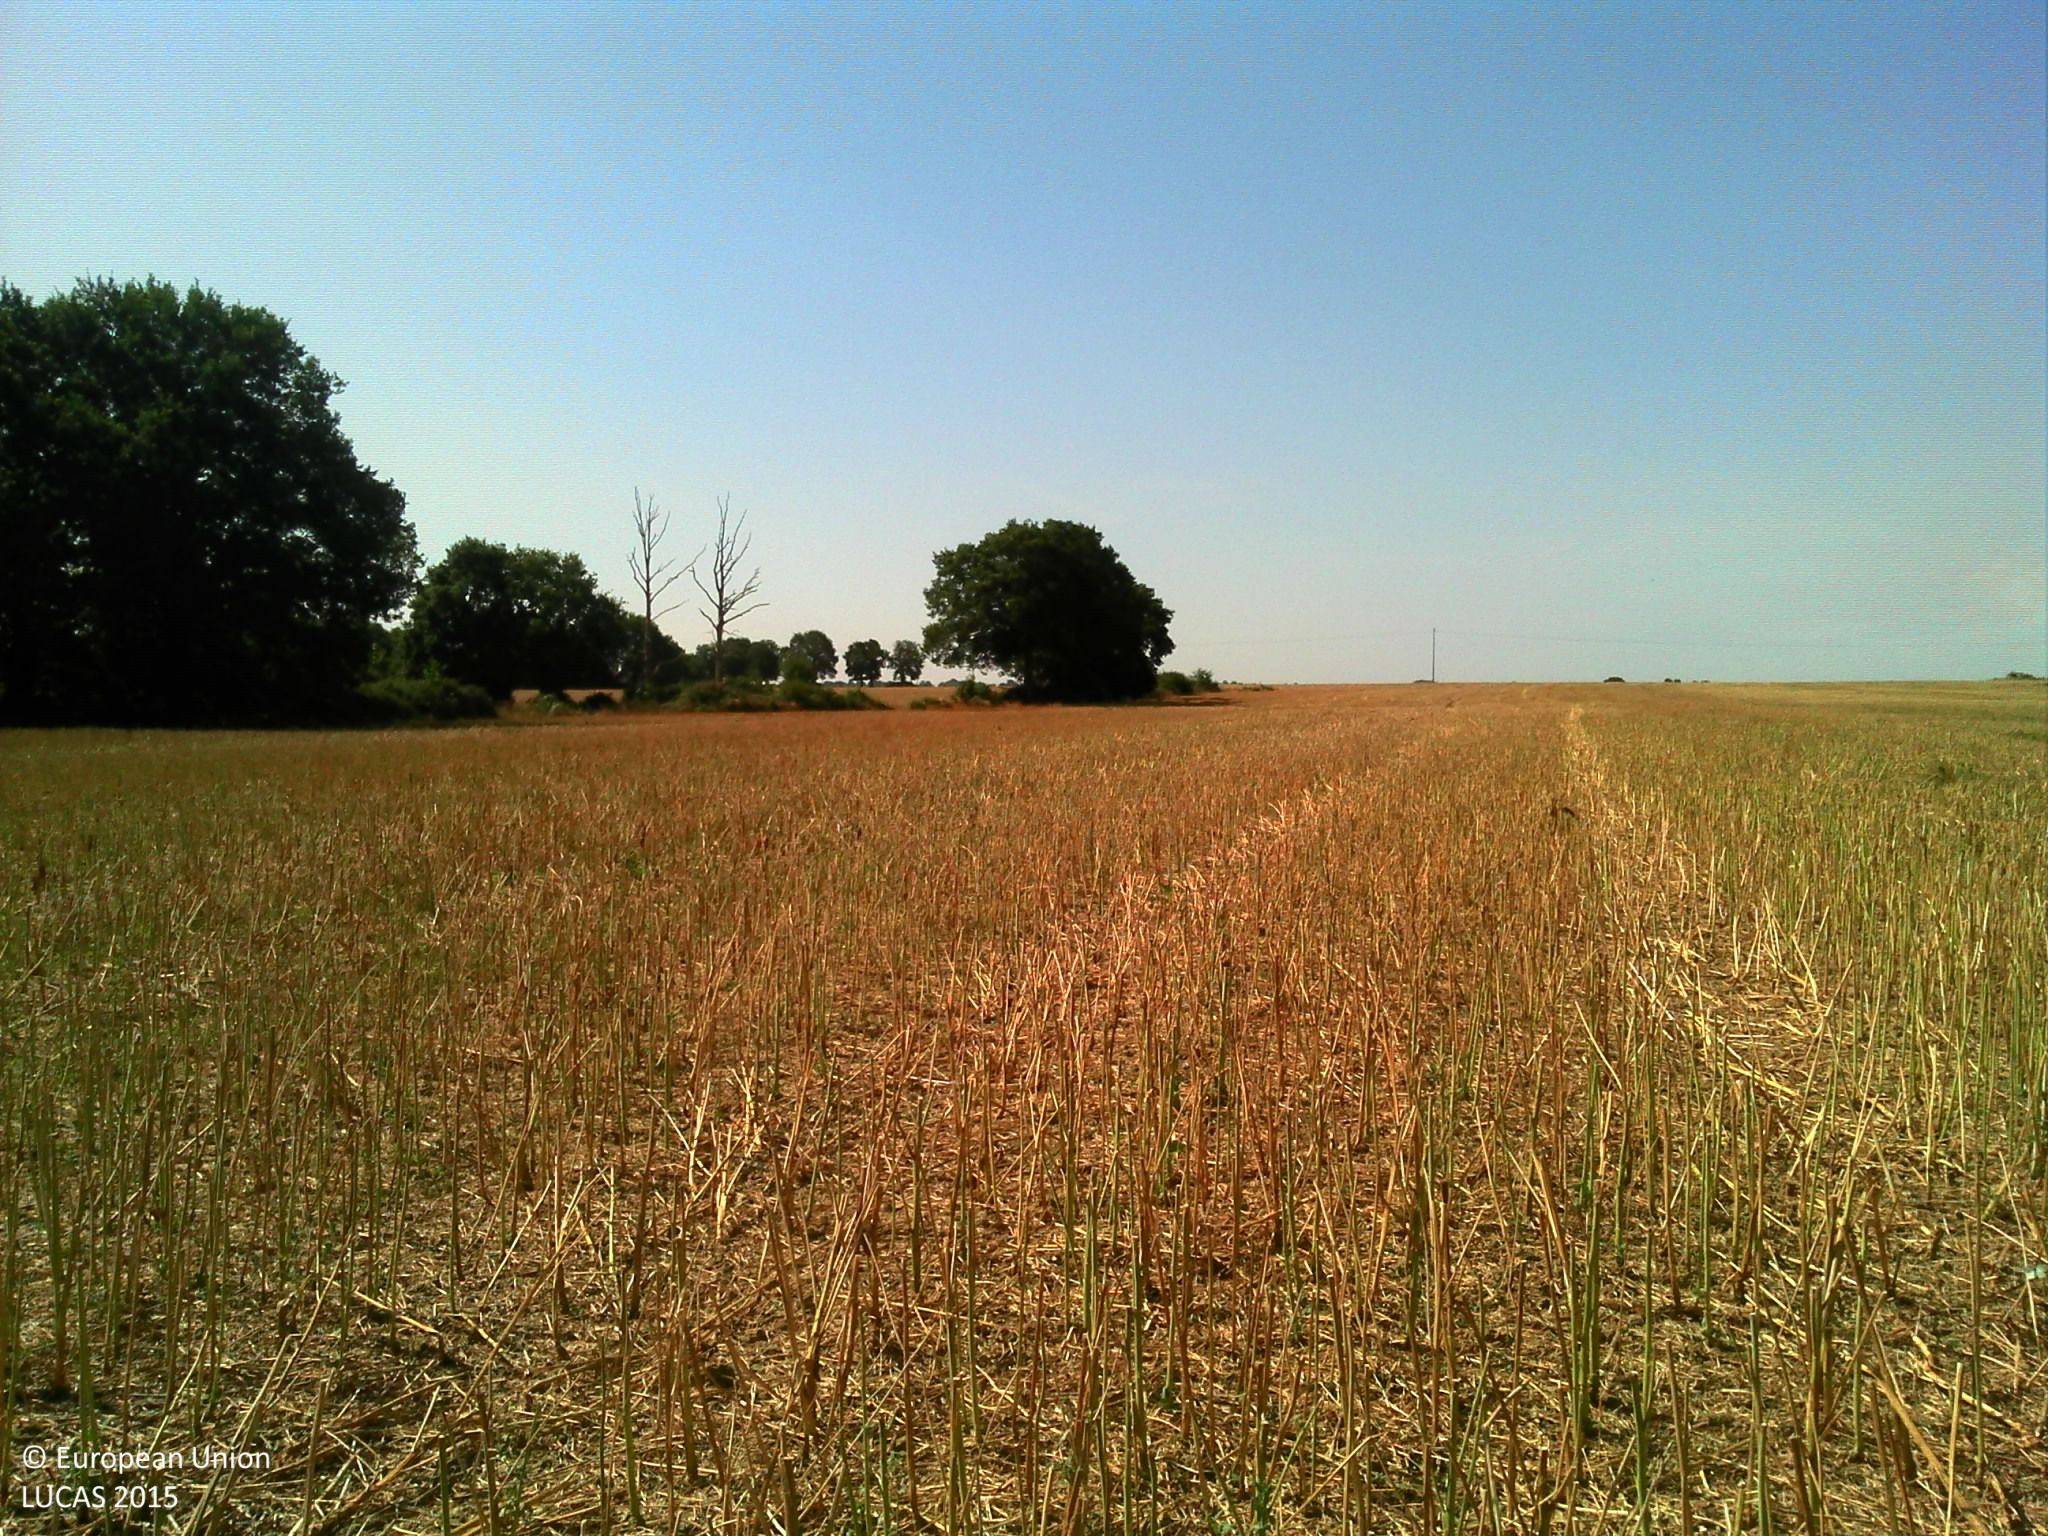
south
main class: Cropland
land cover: Rape and turnip rape
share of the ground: 25 - 50 %
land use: Agriculture (excluding fallow land and kitchen gardens)
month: August
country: FR
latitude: 47.9175
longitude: -1.0790
